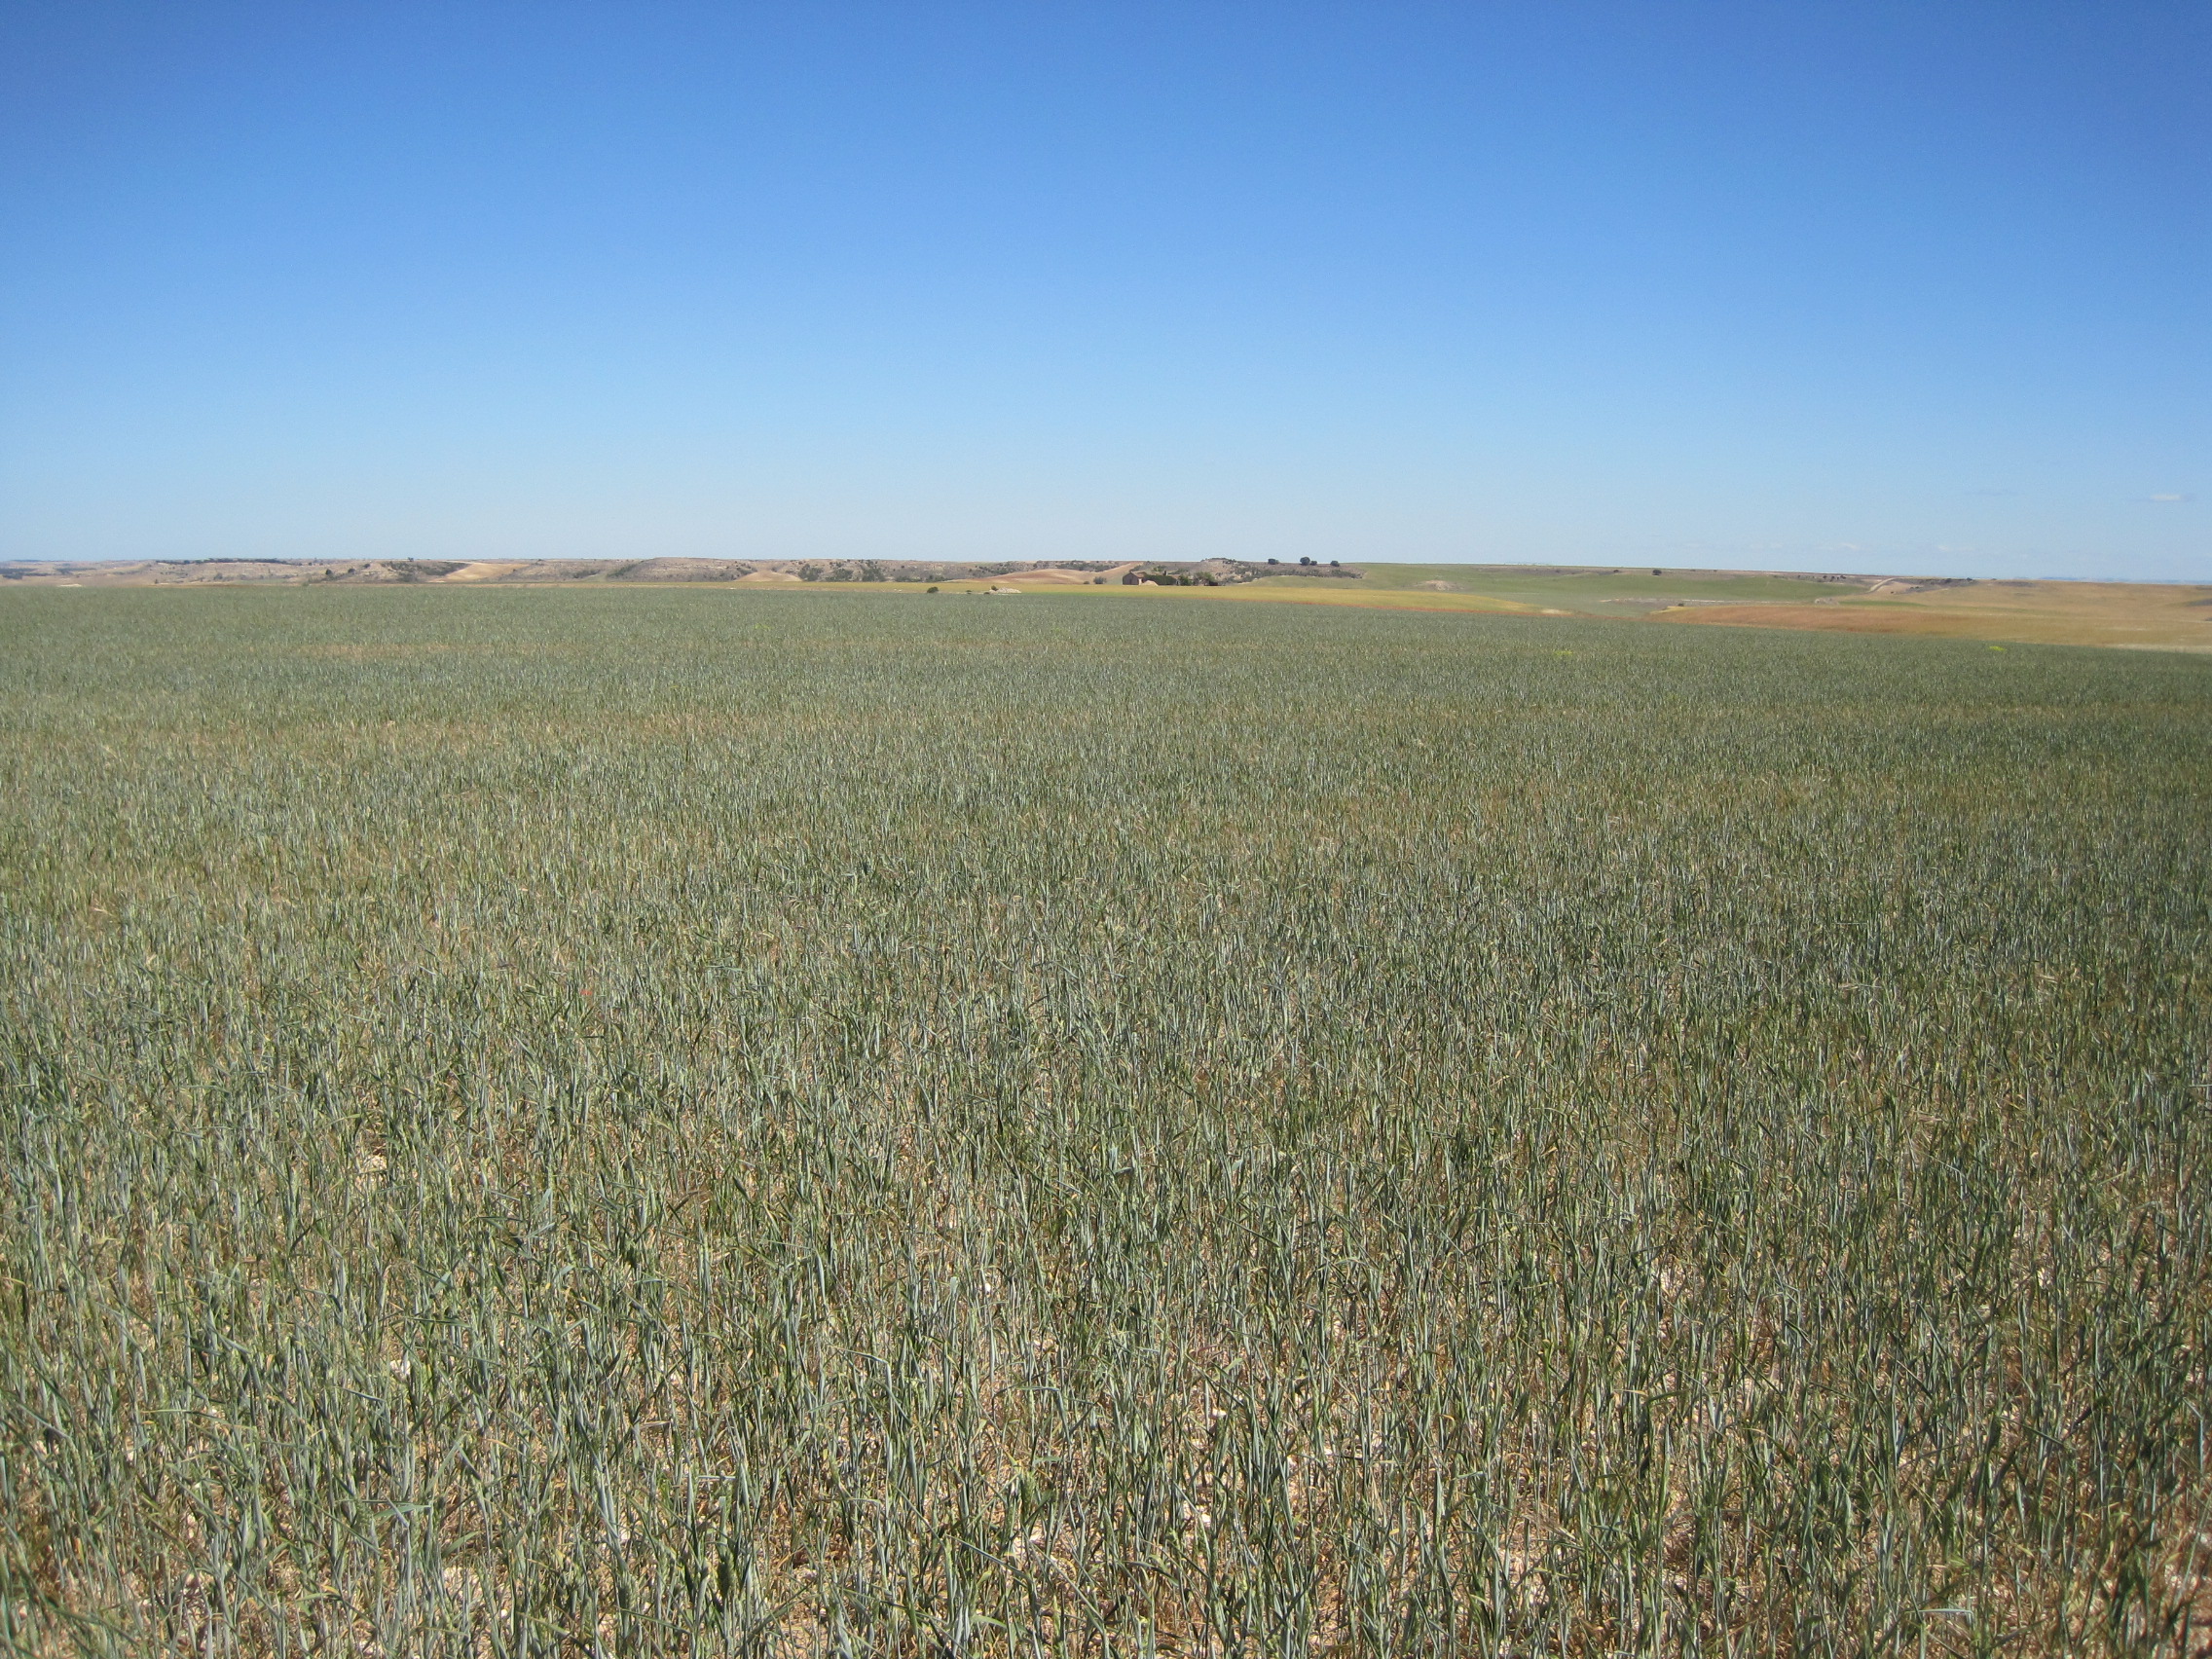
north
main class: Cropland
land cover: Common wheat
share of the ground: > 75 %
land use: Agriculture (excluding fallow land and kitchen gardens)
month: May
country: ES
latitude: 41.2432
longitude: -5.3121
